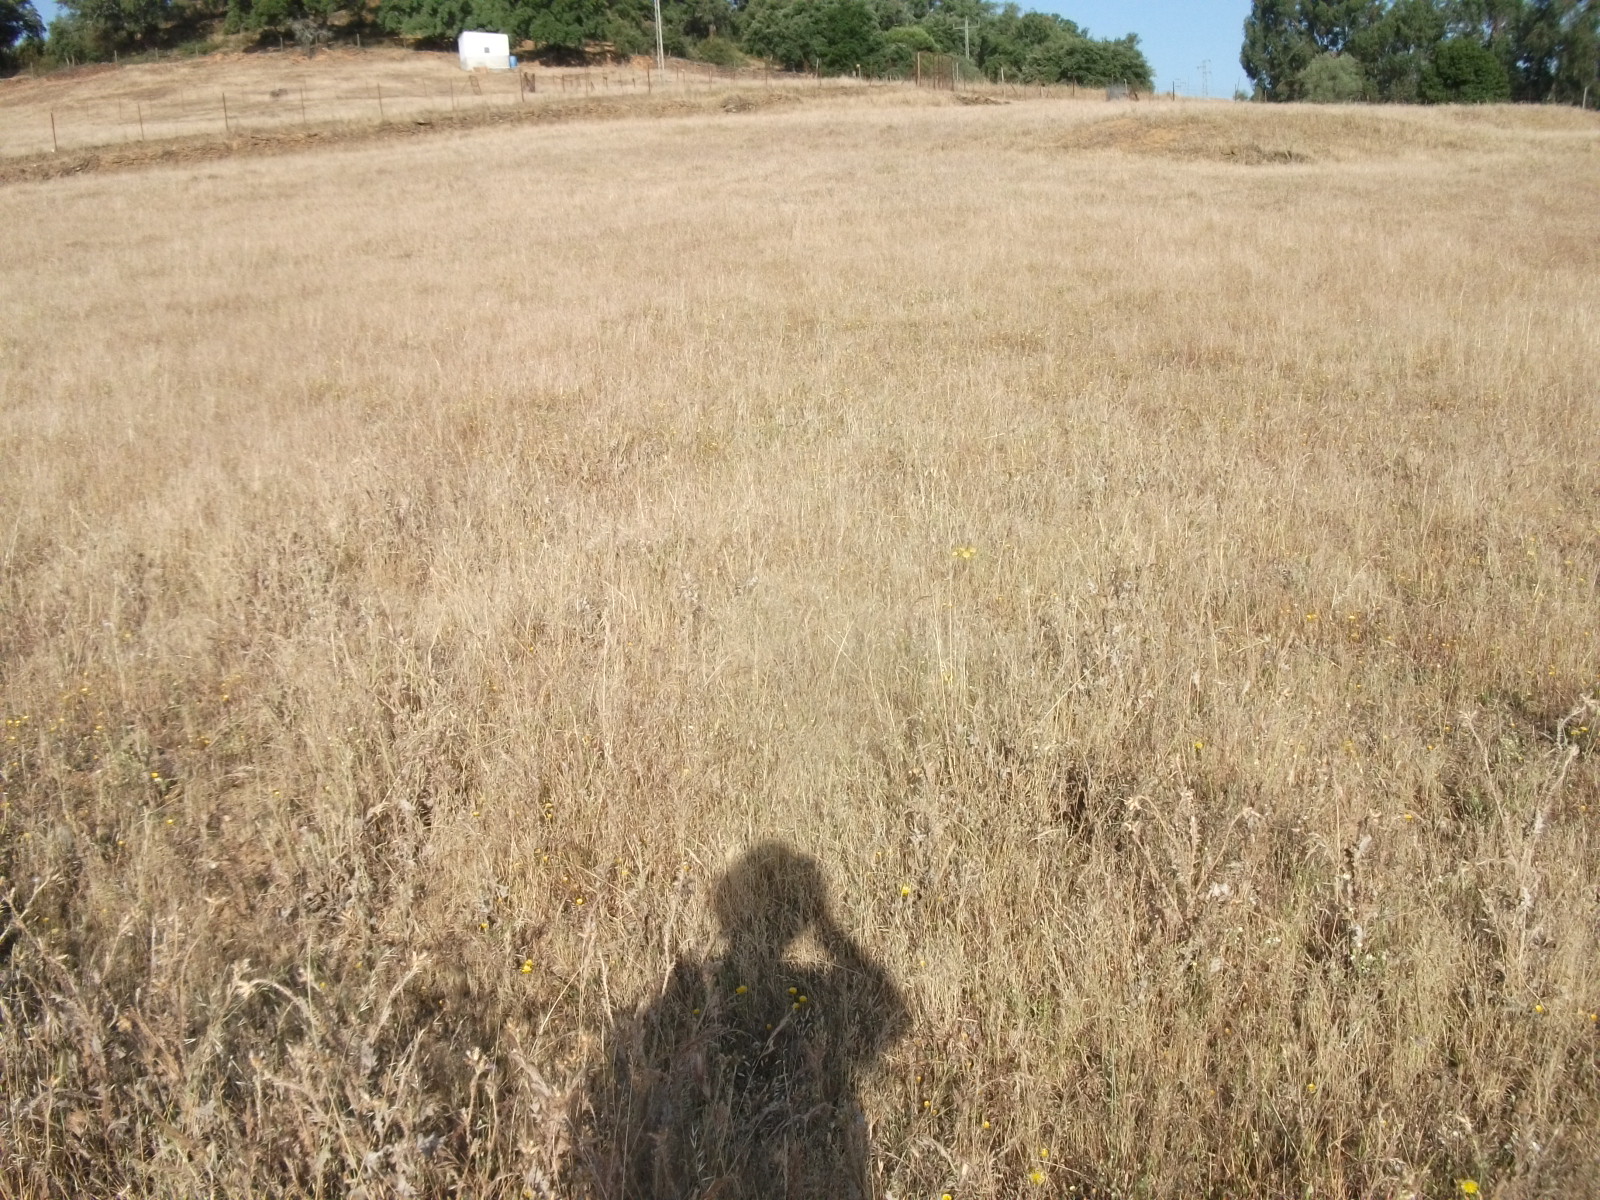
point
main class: Grassland
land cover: Grassland without tree/shrub cover
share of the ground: > 75 %
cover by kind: herbaceous plants 100 %
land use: Agriculture (excluding fallow land and kitchen gardens)
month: May
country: ES
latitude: 37.6361
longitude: -6.6415
